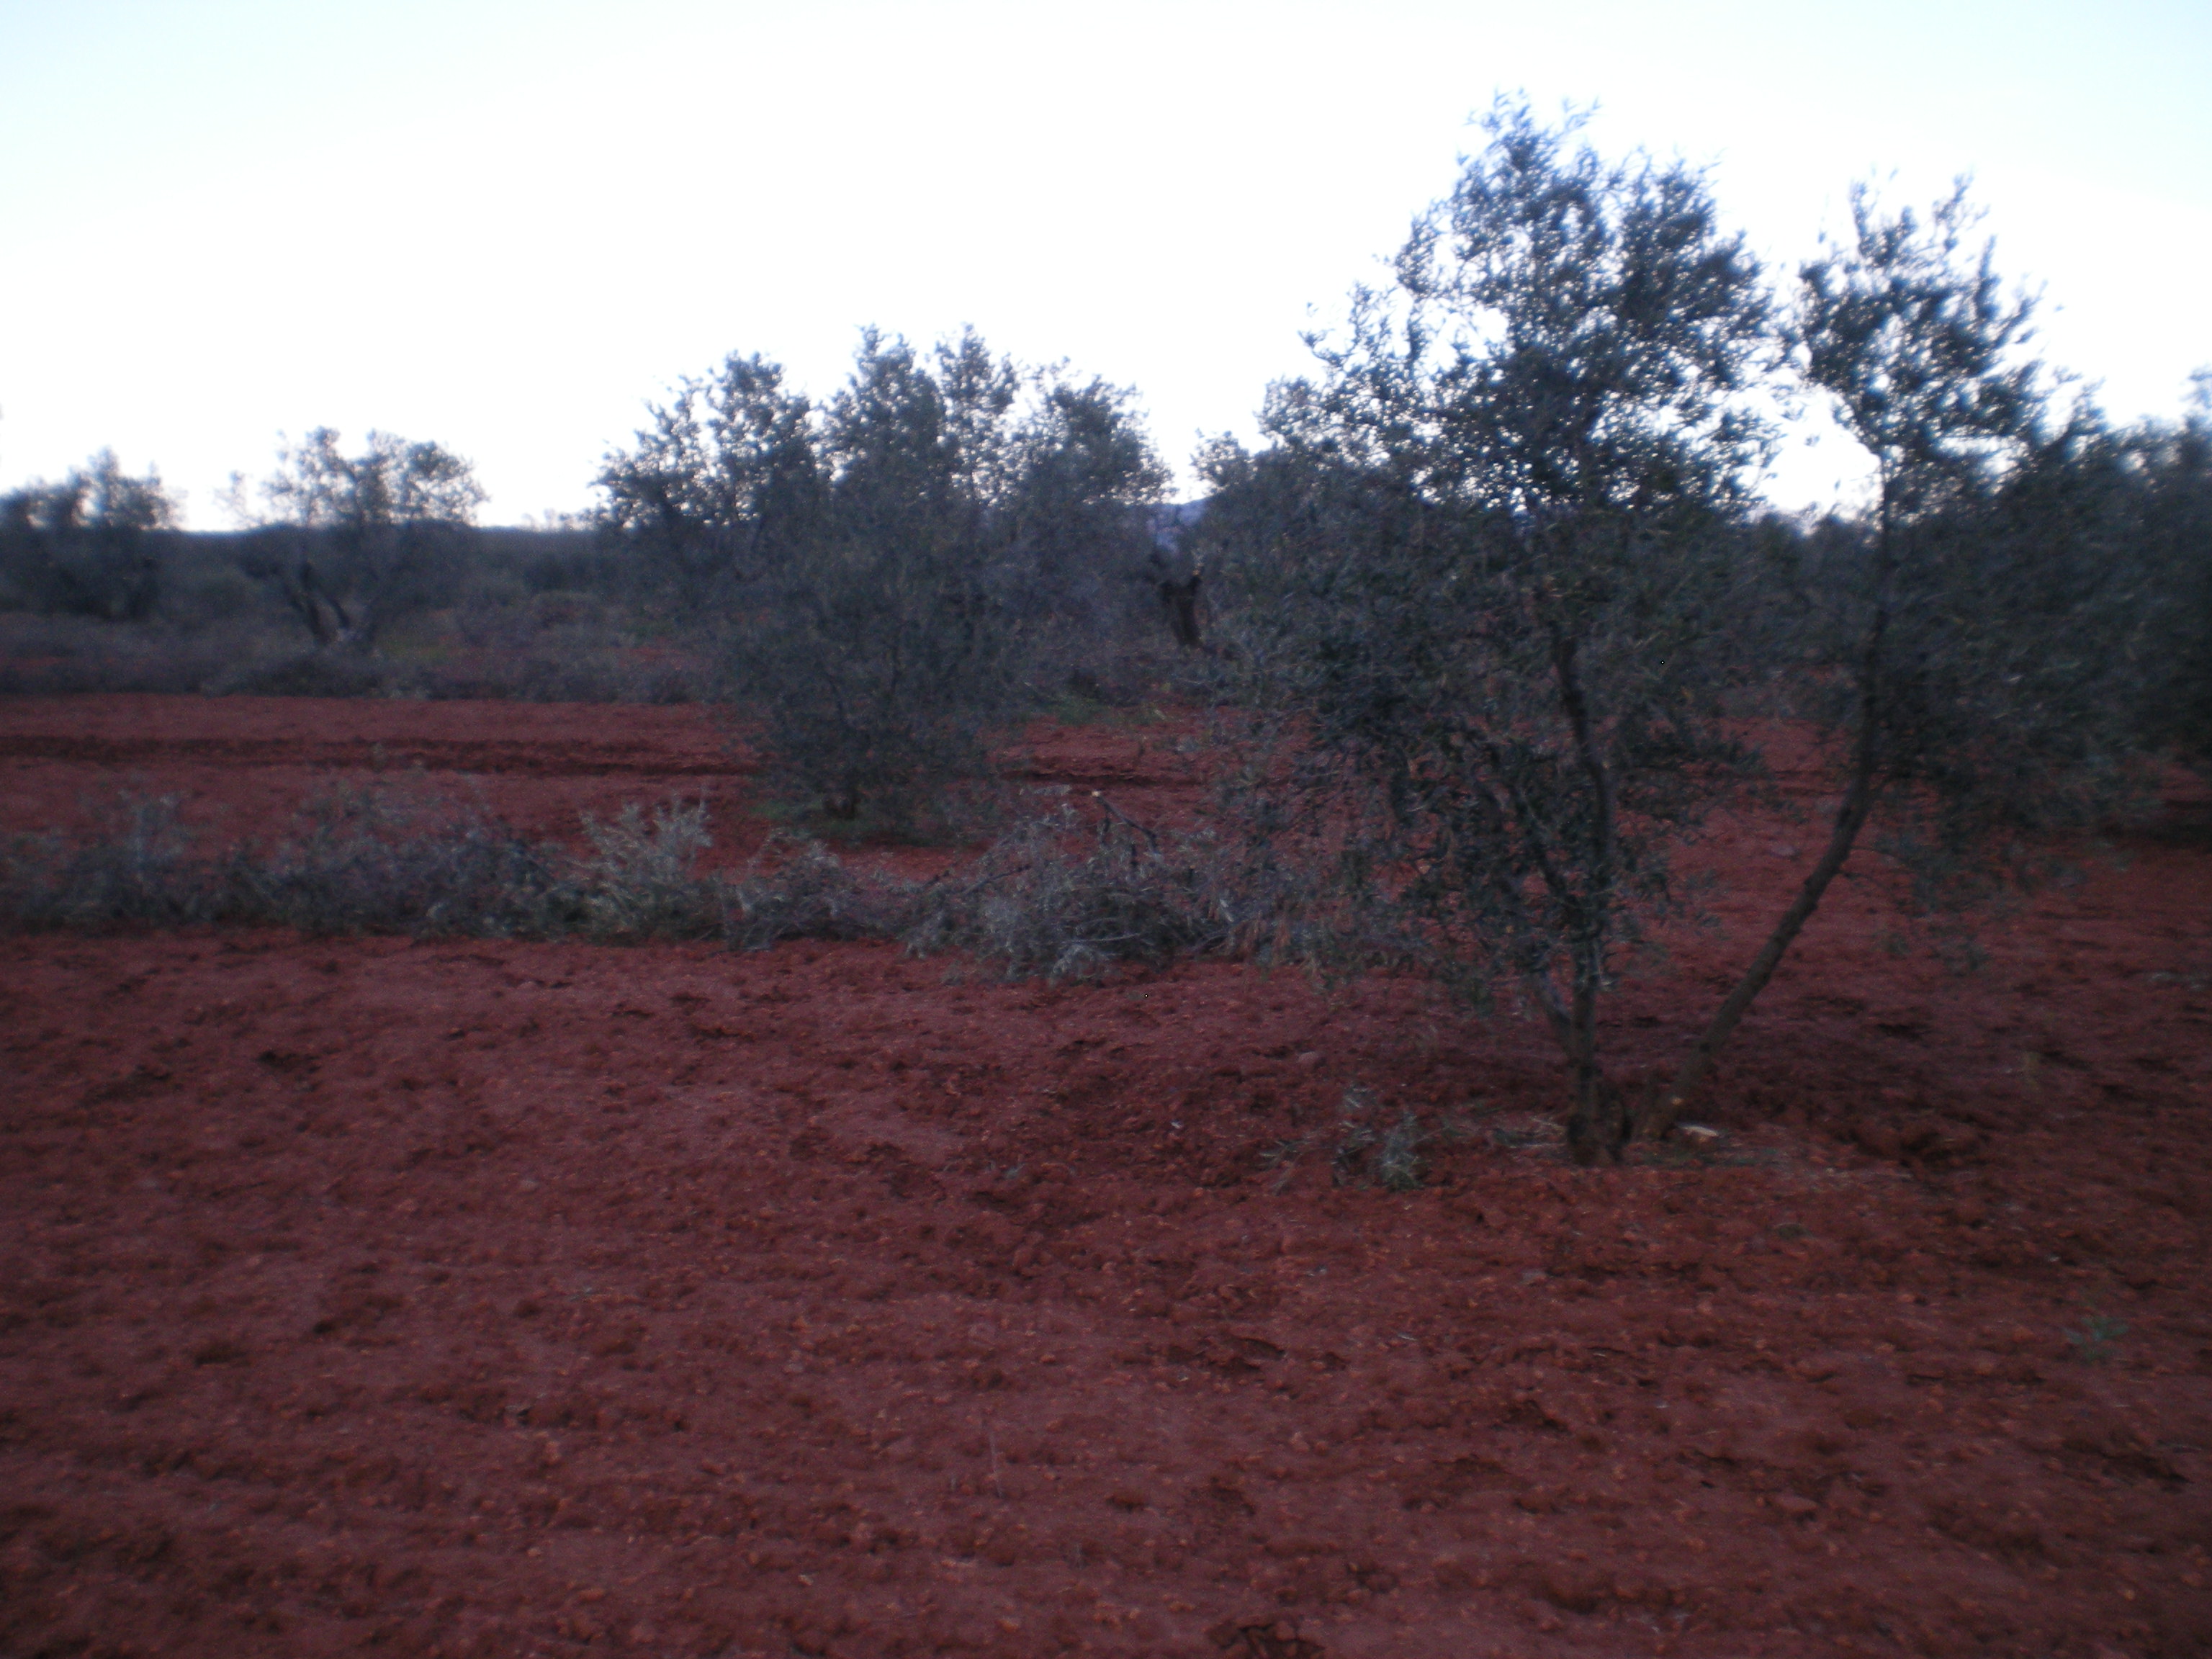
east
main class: Cropland
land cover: Olive groves
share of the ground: 10 - 25 %
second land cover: Other bare soil
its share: > 75 %
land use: Agriculture (excluding fallow land and kitchen gardens)
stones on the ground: < 10 %
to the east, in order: Olive groves; Other bare soil; Grass margins; Olive groves; Vineyards; Grassland without tree/shrub cover; Tracks; Grassland without tree/shrub cover; Olive groves
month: April
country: ES
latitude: 38.6479
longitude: -3.3953
